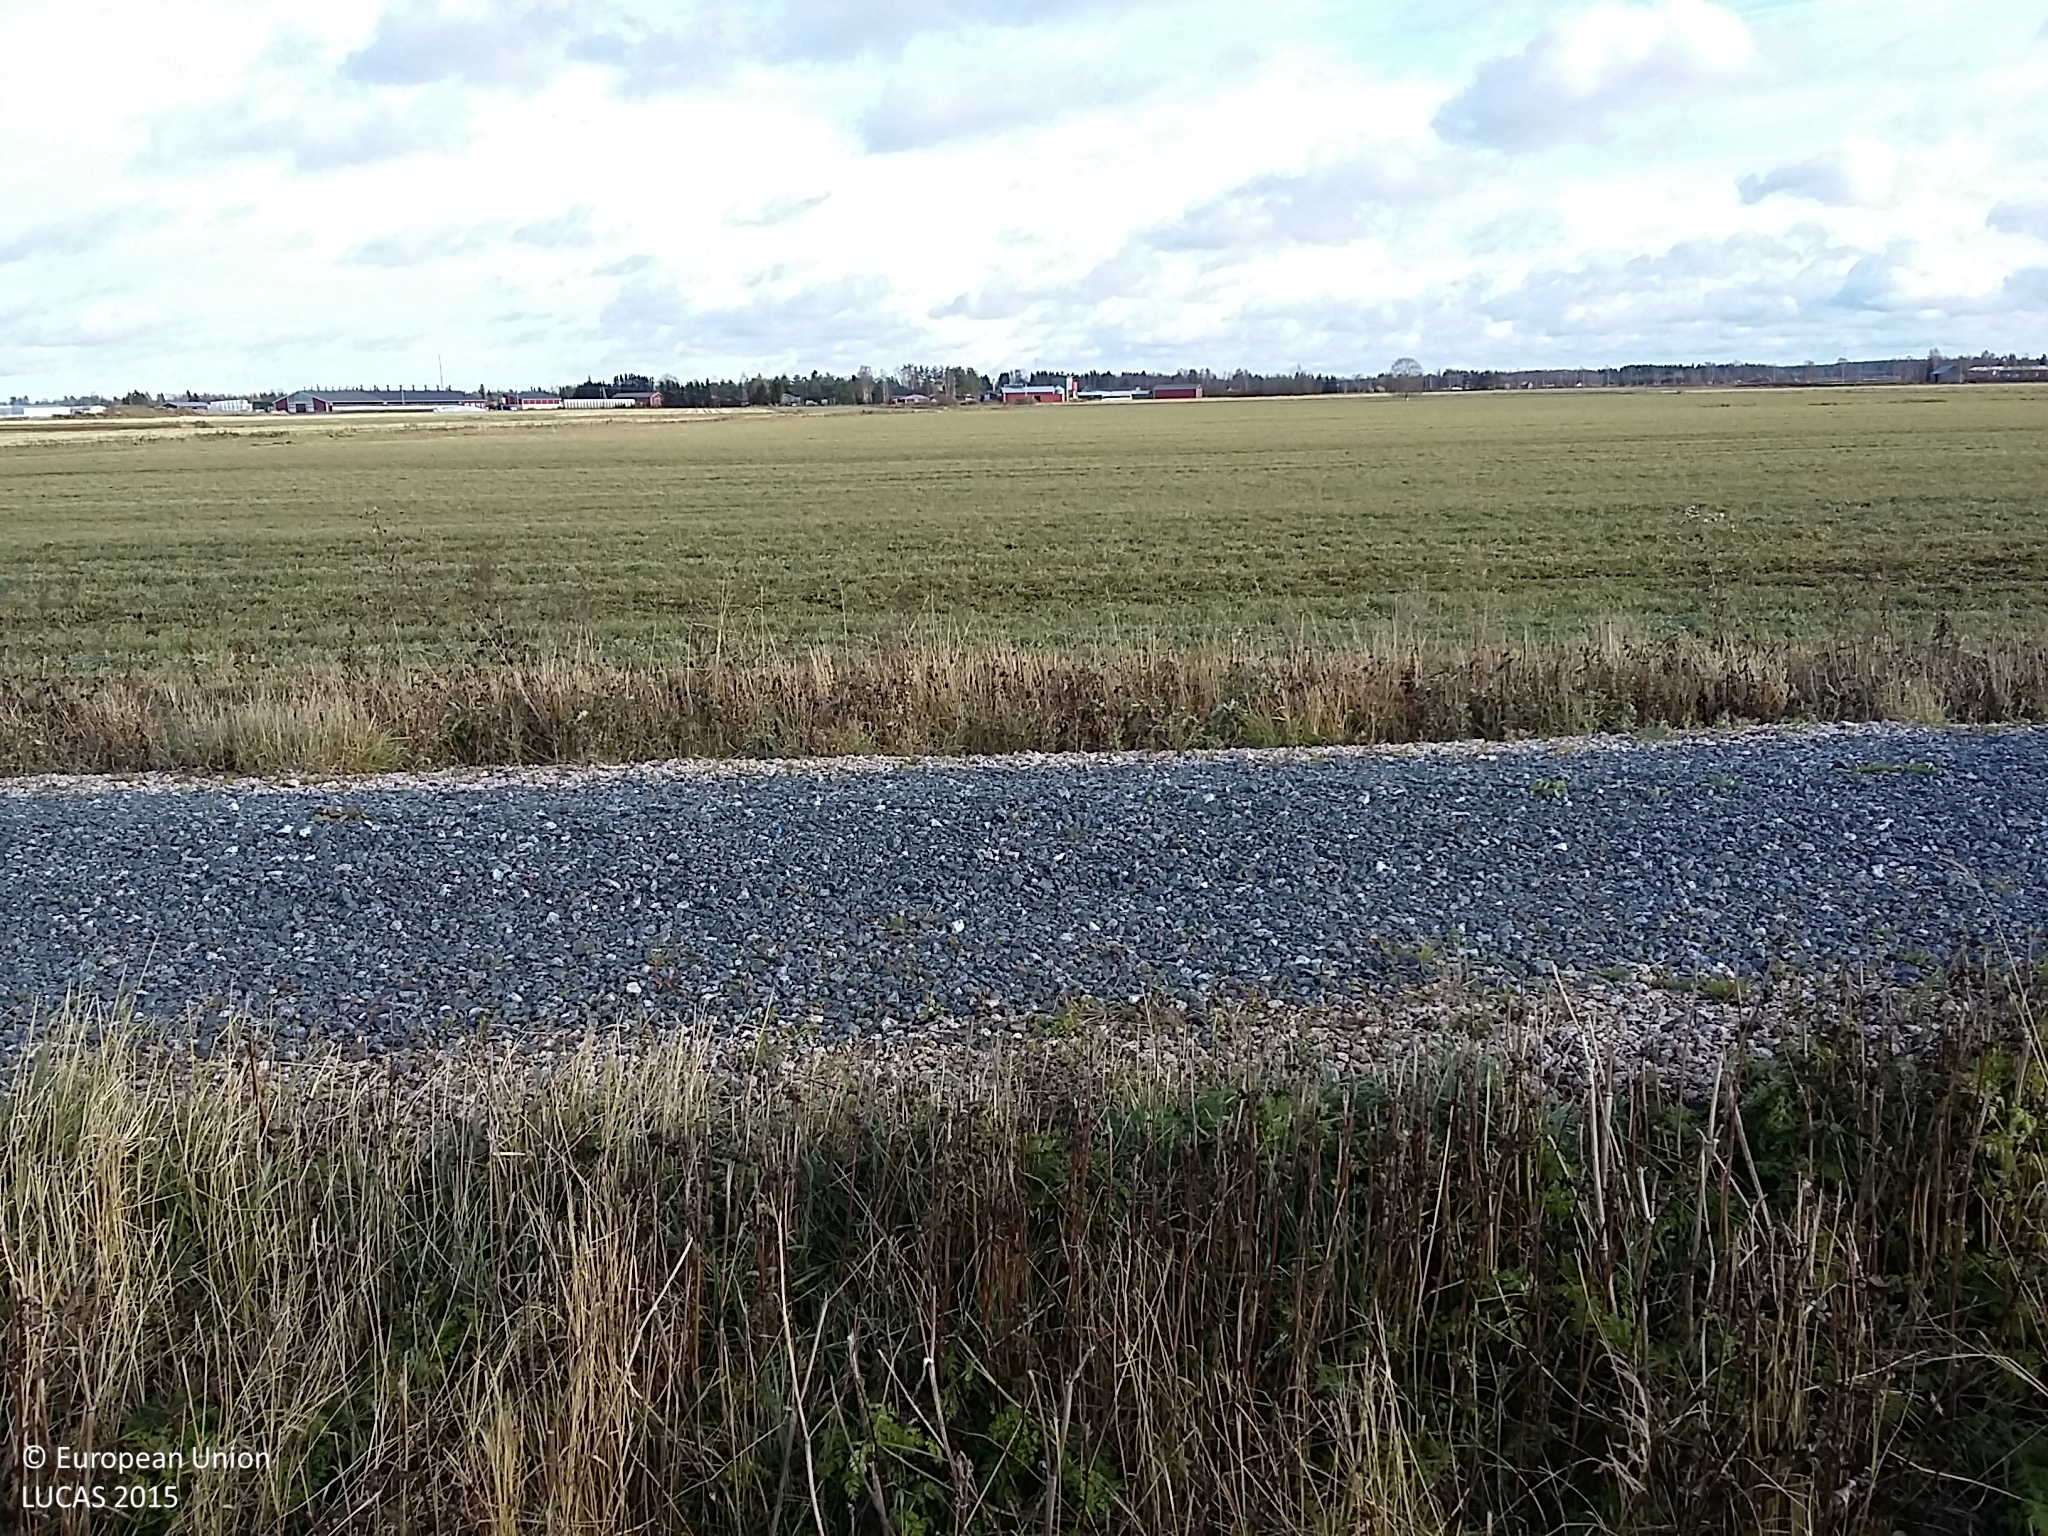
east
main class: Cropland
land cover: Temporary grasslands
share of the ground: > 75 %
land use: Agriculture (excluding fallow land and kitchen gardens)
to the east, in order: Temporary grasslands; Grass margins; Ditches and canals; Shruby margins; Tracks; Shruby margins; Ditches and canals; Grass margins; Temporary grasslands
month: October
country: FI
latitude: 63.9280
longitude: 24.9097
